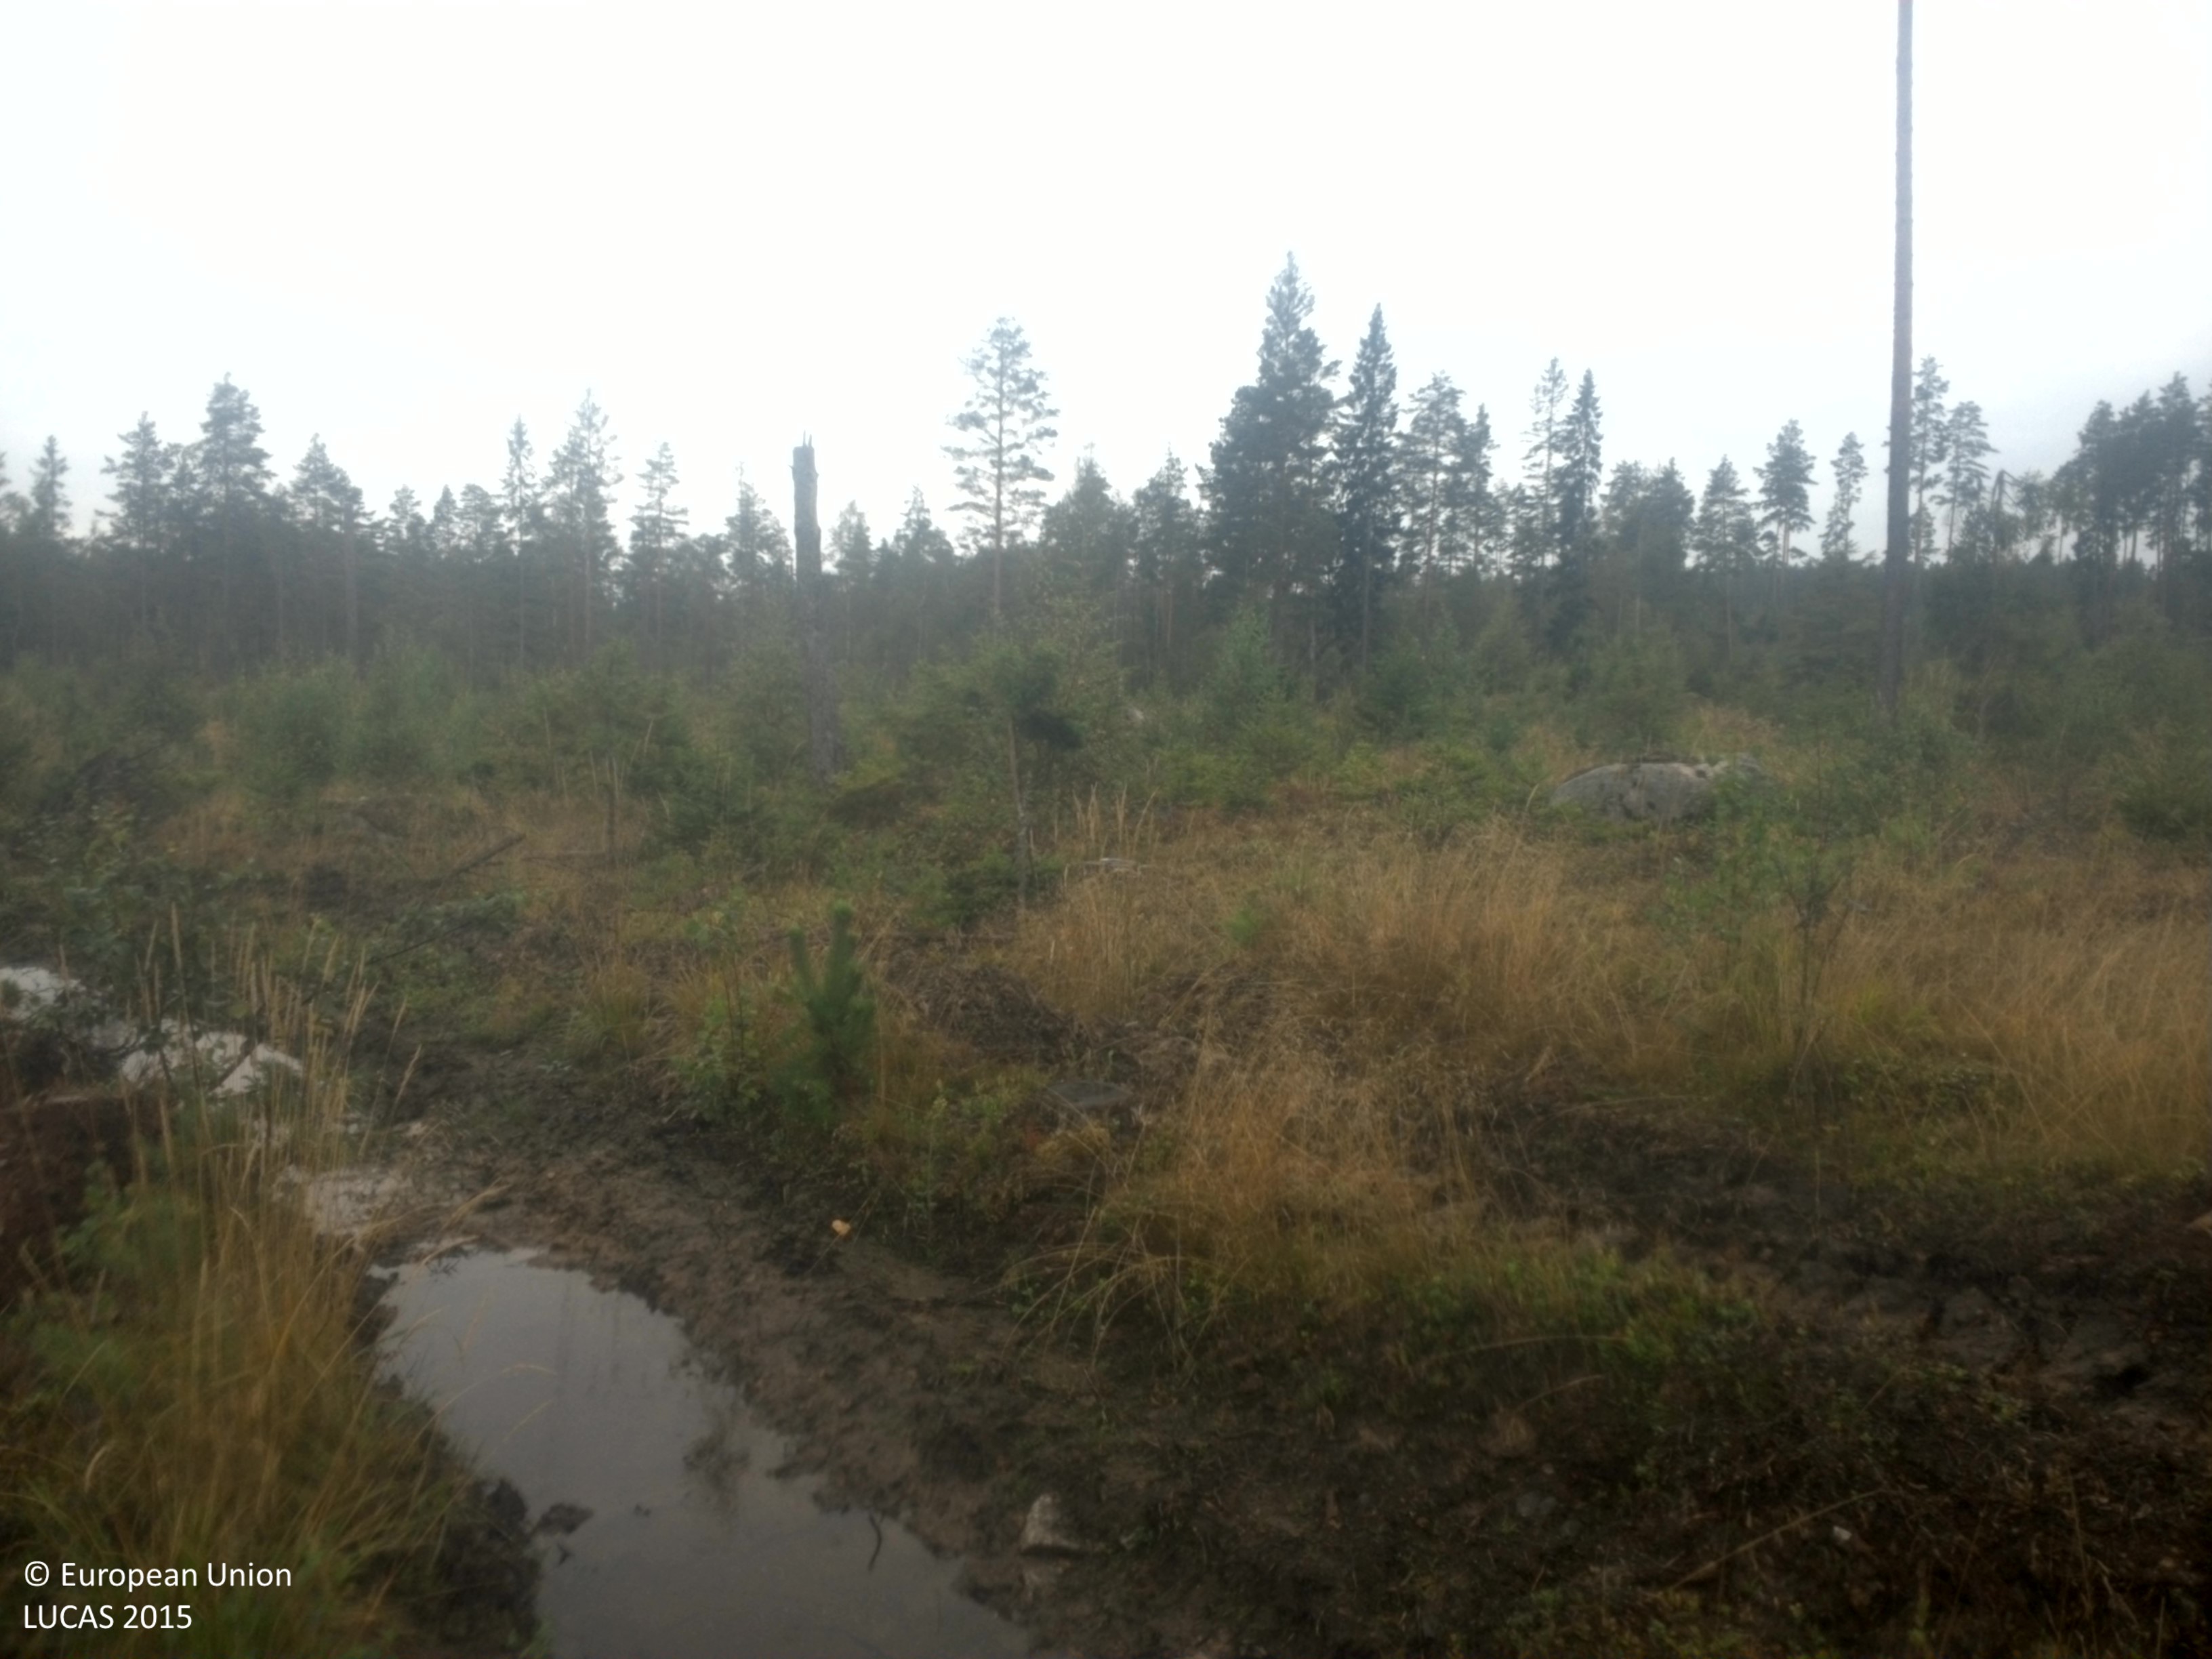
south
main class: Woodland
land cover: Pine dominated mixed woodland
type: boreal forest
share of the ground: 50 - 75 %
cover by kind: broadleaved forest trees 30 %, herbaceous plants 30 %, coniferous forest trees 20 %, shrubs 15 %, unconsolidated bare surface 5 %
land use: Forestry
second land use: Amenities, museums, leisure
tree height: < 5 m
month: September
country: SE
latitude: 59.6688
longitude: 15.6894
